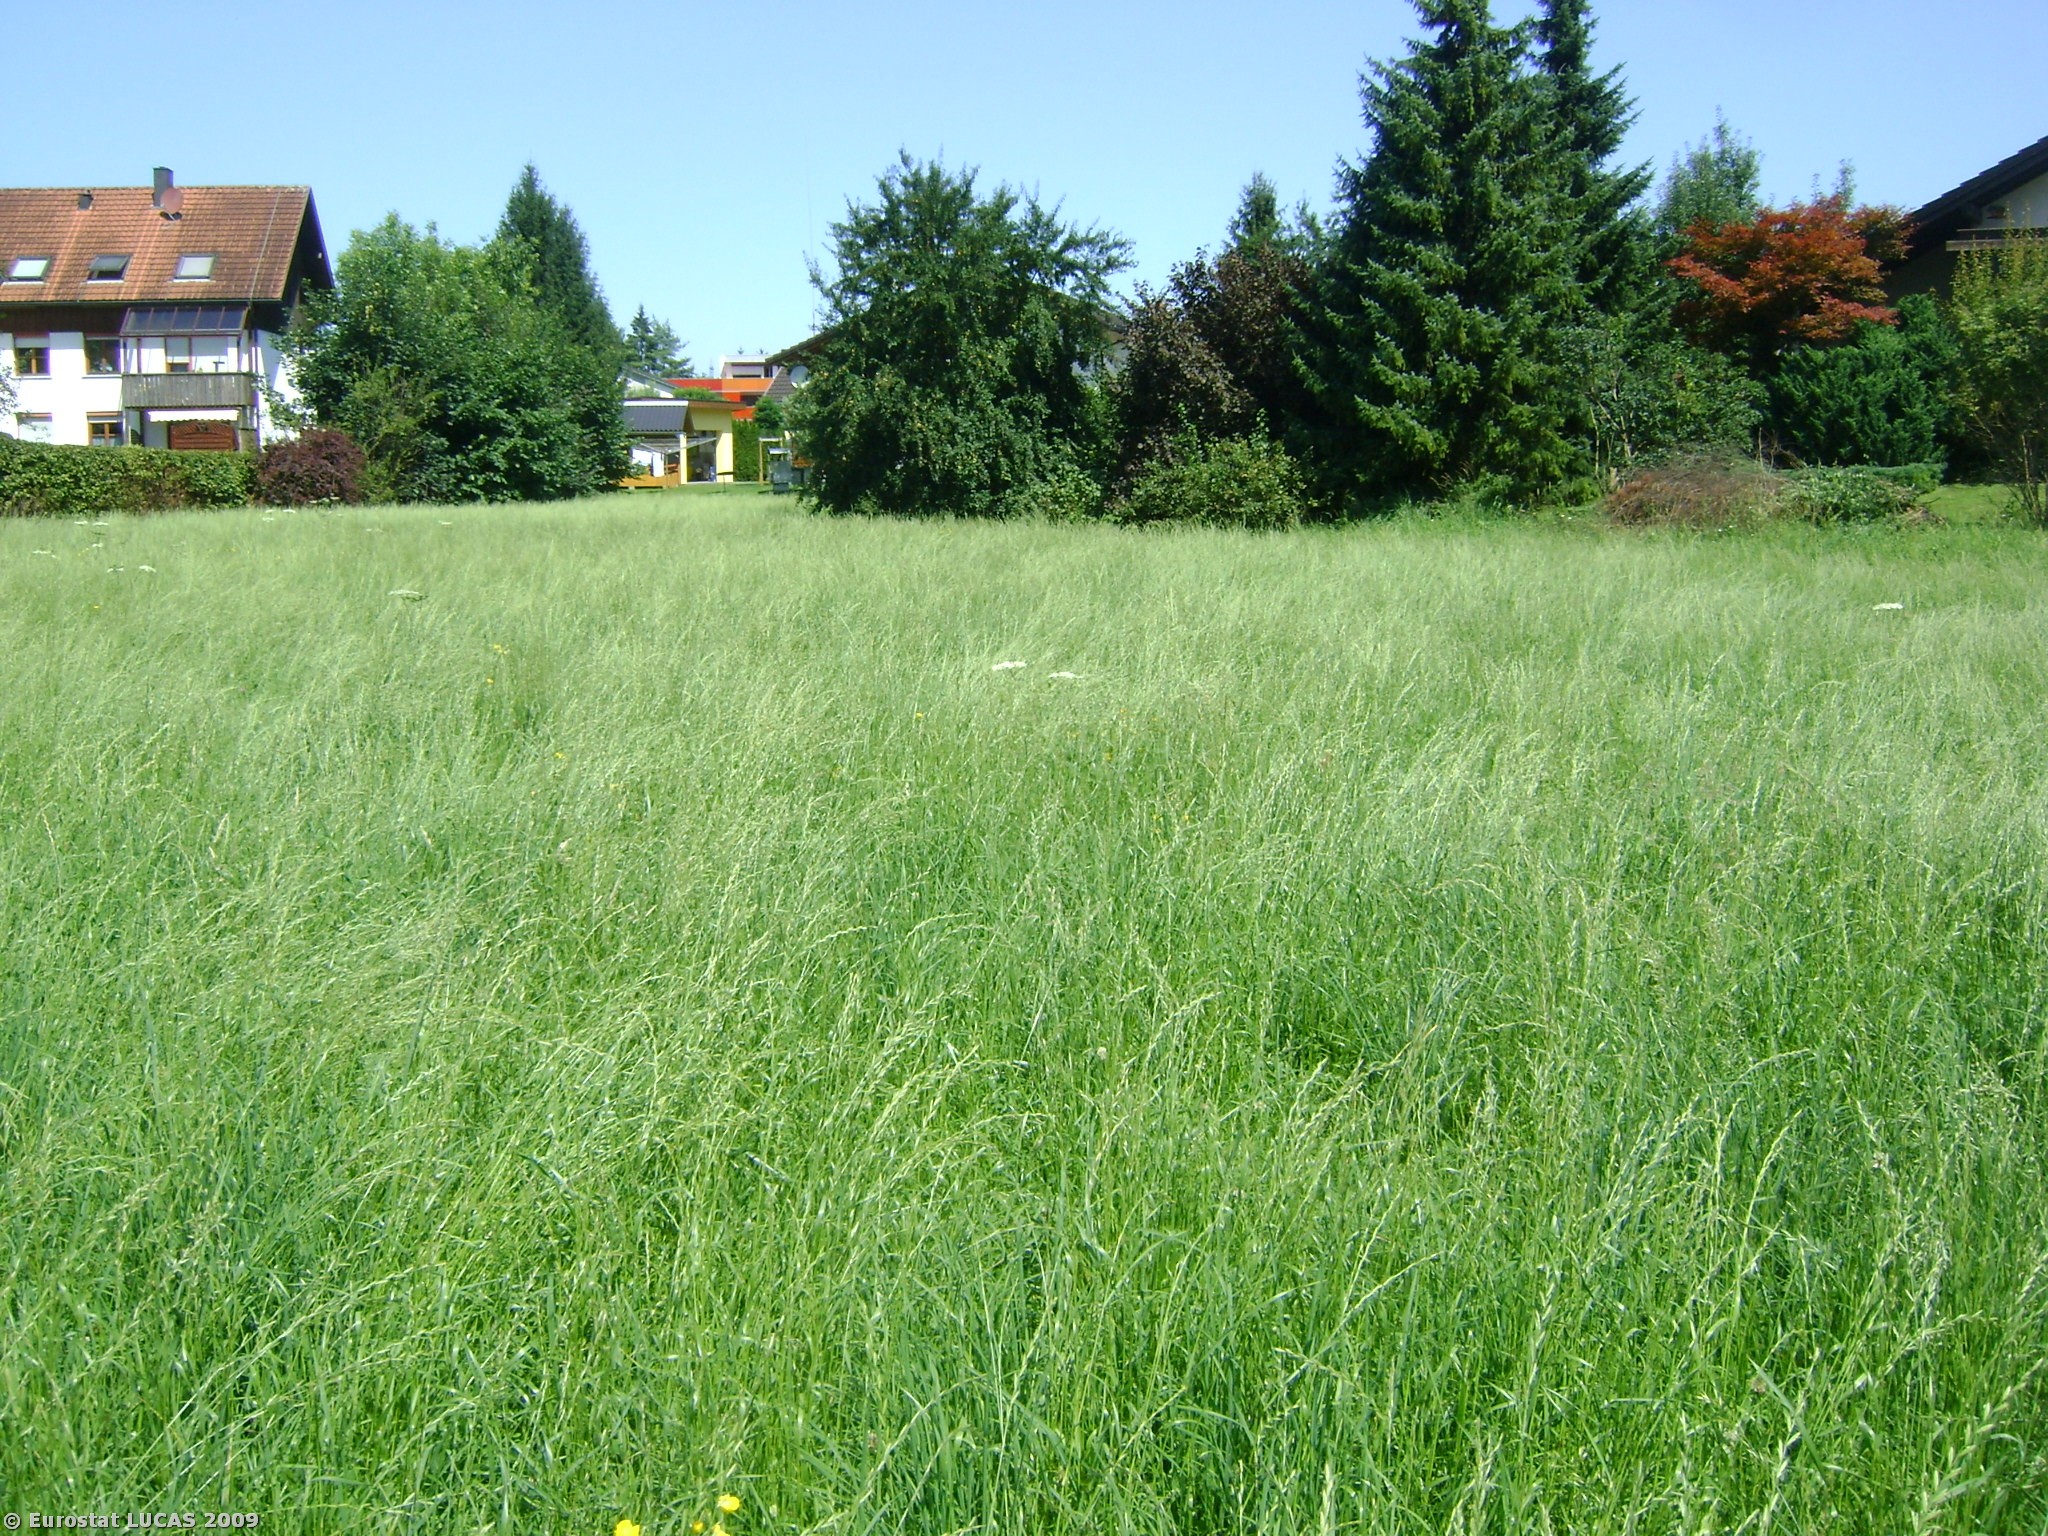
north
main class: Grassland
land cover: Grassland without tree/shrub cover
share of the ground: > 75 %
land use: Agriculture (excluding fallow land and kitchen gardens)
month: July
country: AT
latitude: 47.3591
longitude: 9.6693
